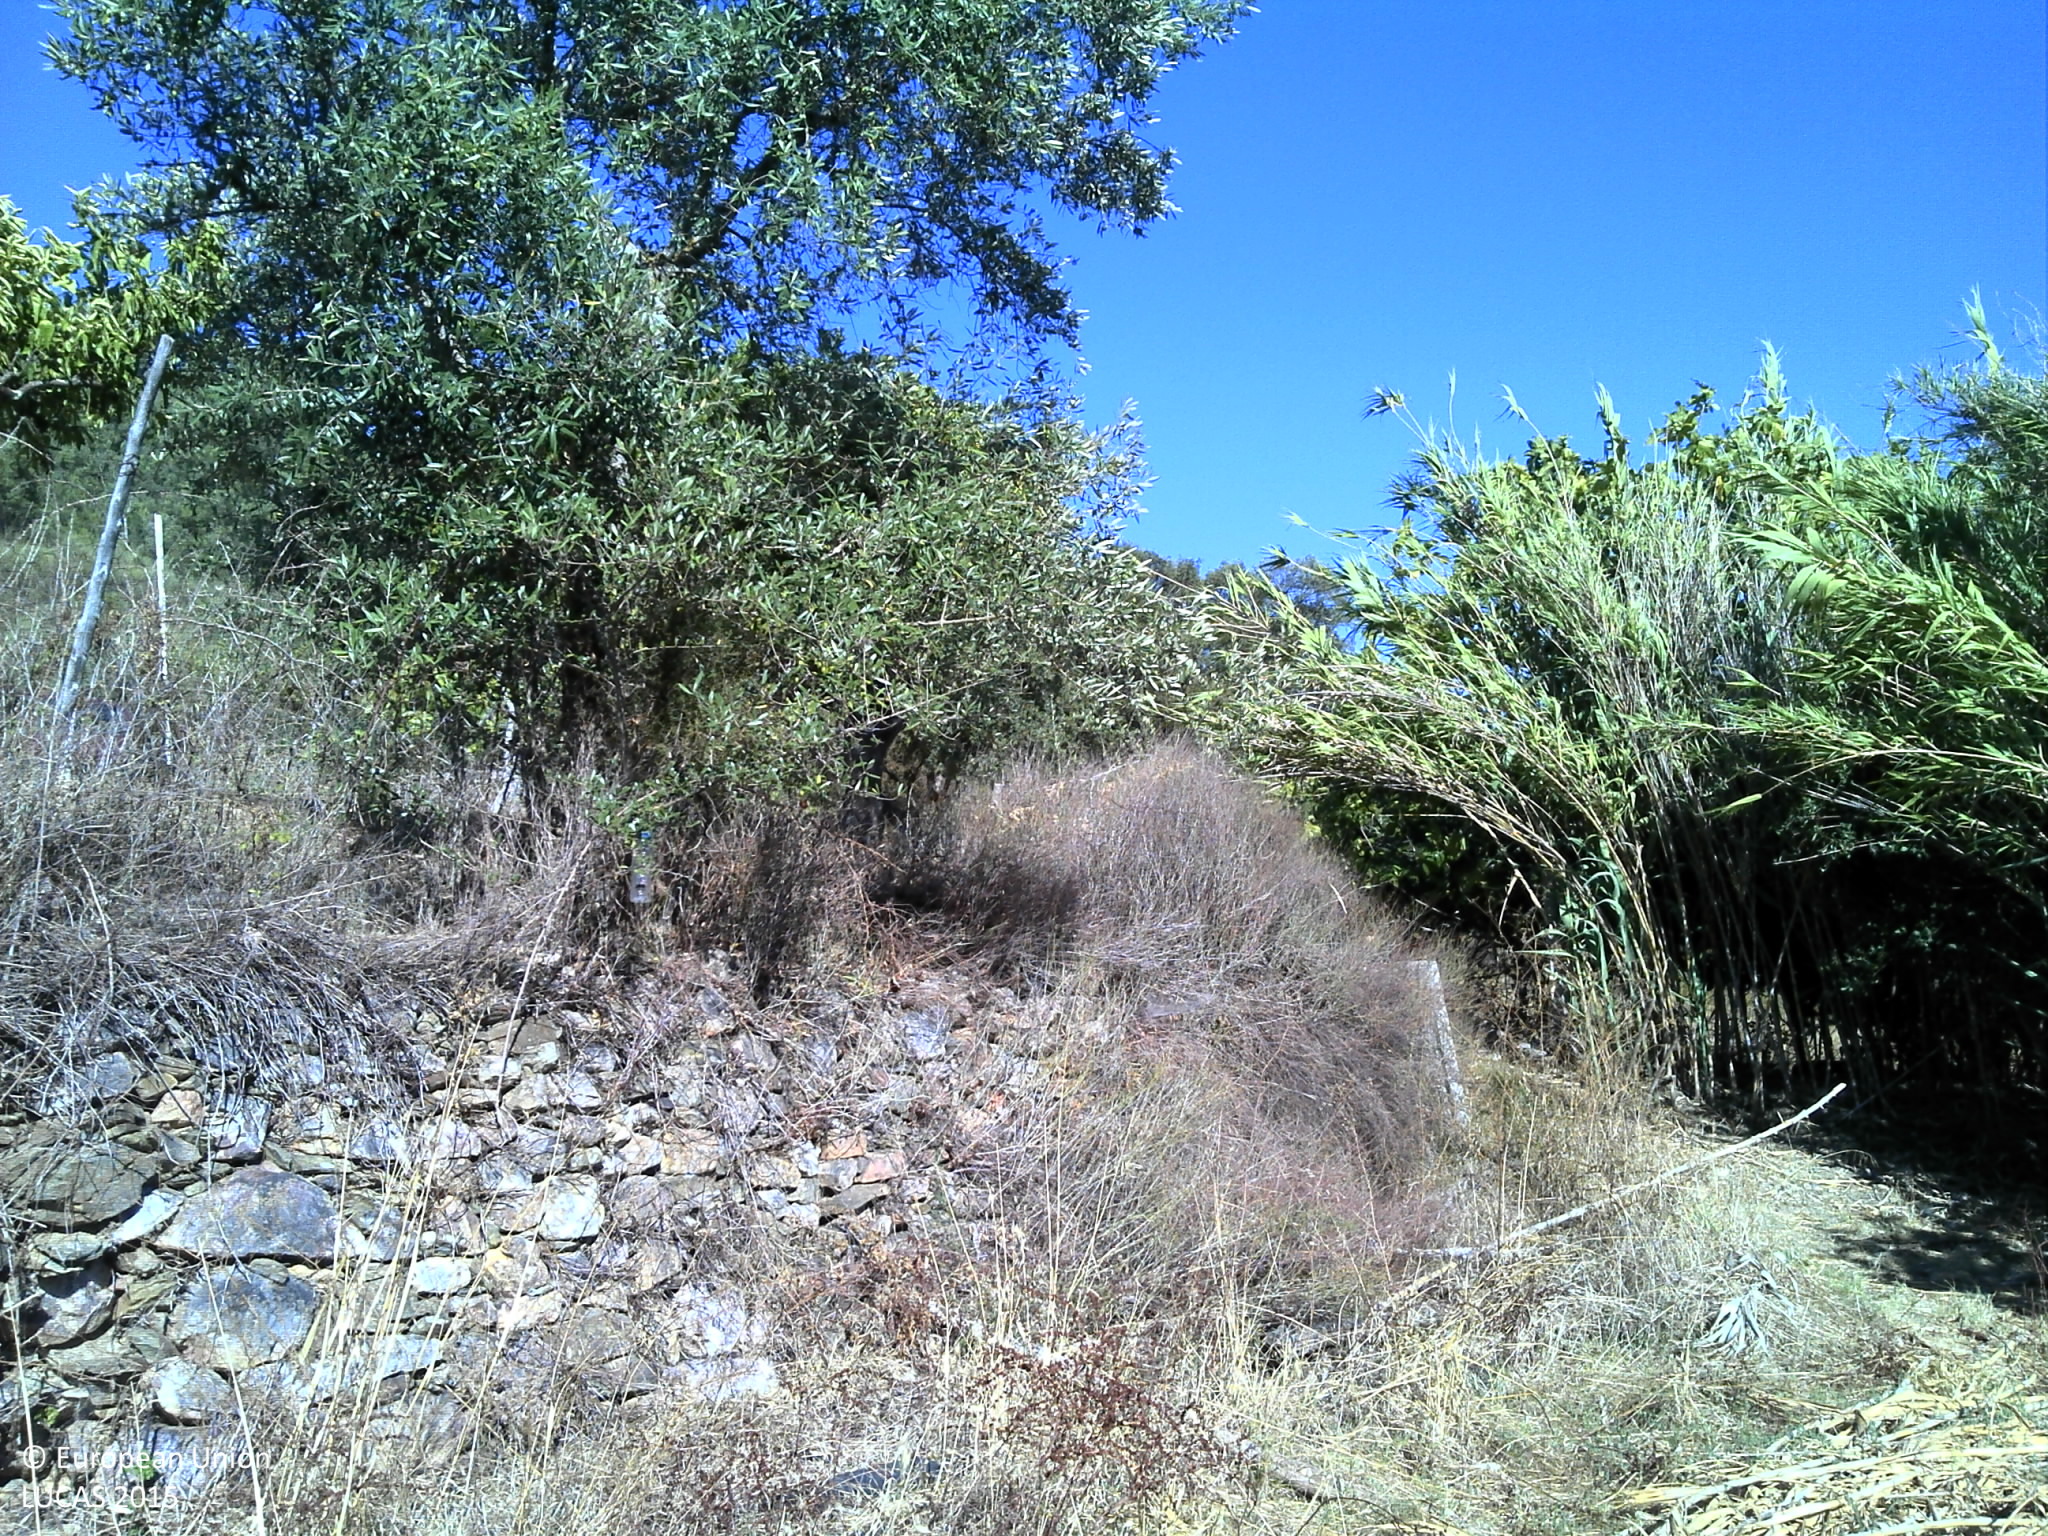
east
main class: Cropland
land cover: Other fruit trees and berries
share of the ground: 10 - 25 %
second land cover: Grassland without tree/shrub cover
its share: 10 - 25 %
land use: Agriculture (excluding fallow land and kitchen gardens)
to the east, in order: Other fruit trees and berries; Grassland without tree/shrub cover; Other fruit trees and berries; Fences; Dry stone walls; Other fruit trees and berries; Fences; Grass margins; Fences; Other fruit trees and berries; Fences; Broadleaved woodland; Tracks; Broadleaved woodland; Pine dominated mixed woodland; Shrubland without tree cover; Tracks; Shrubland without tree cover; Pine dominated mixed woodland
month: August
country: PT
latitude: 39.5776
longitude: -7.6425
